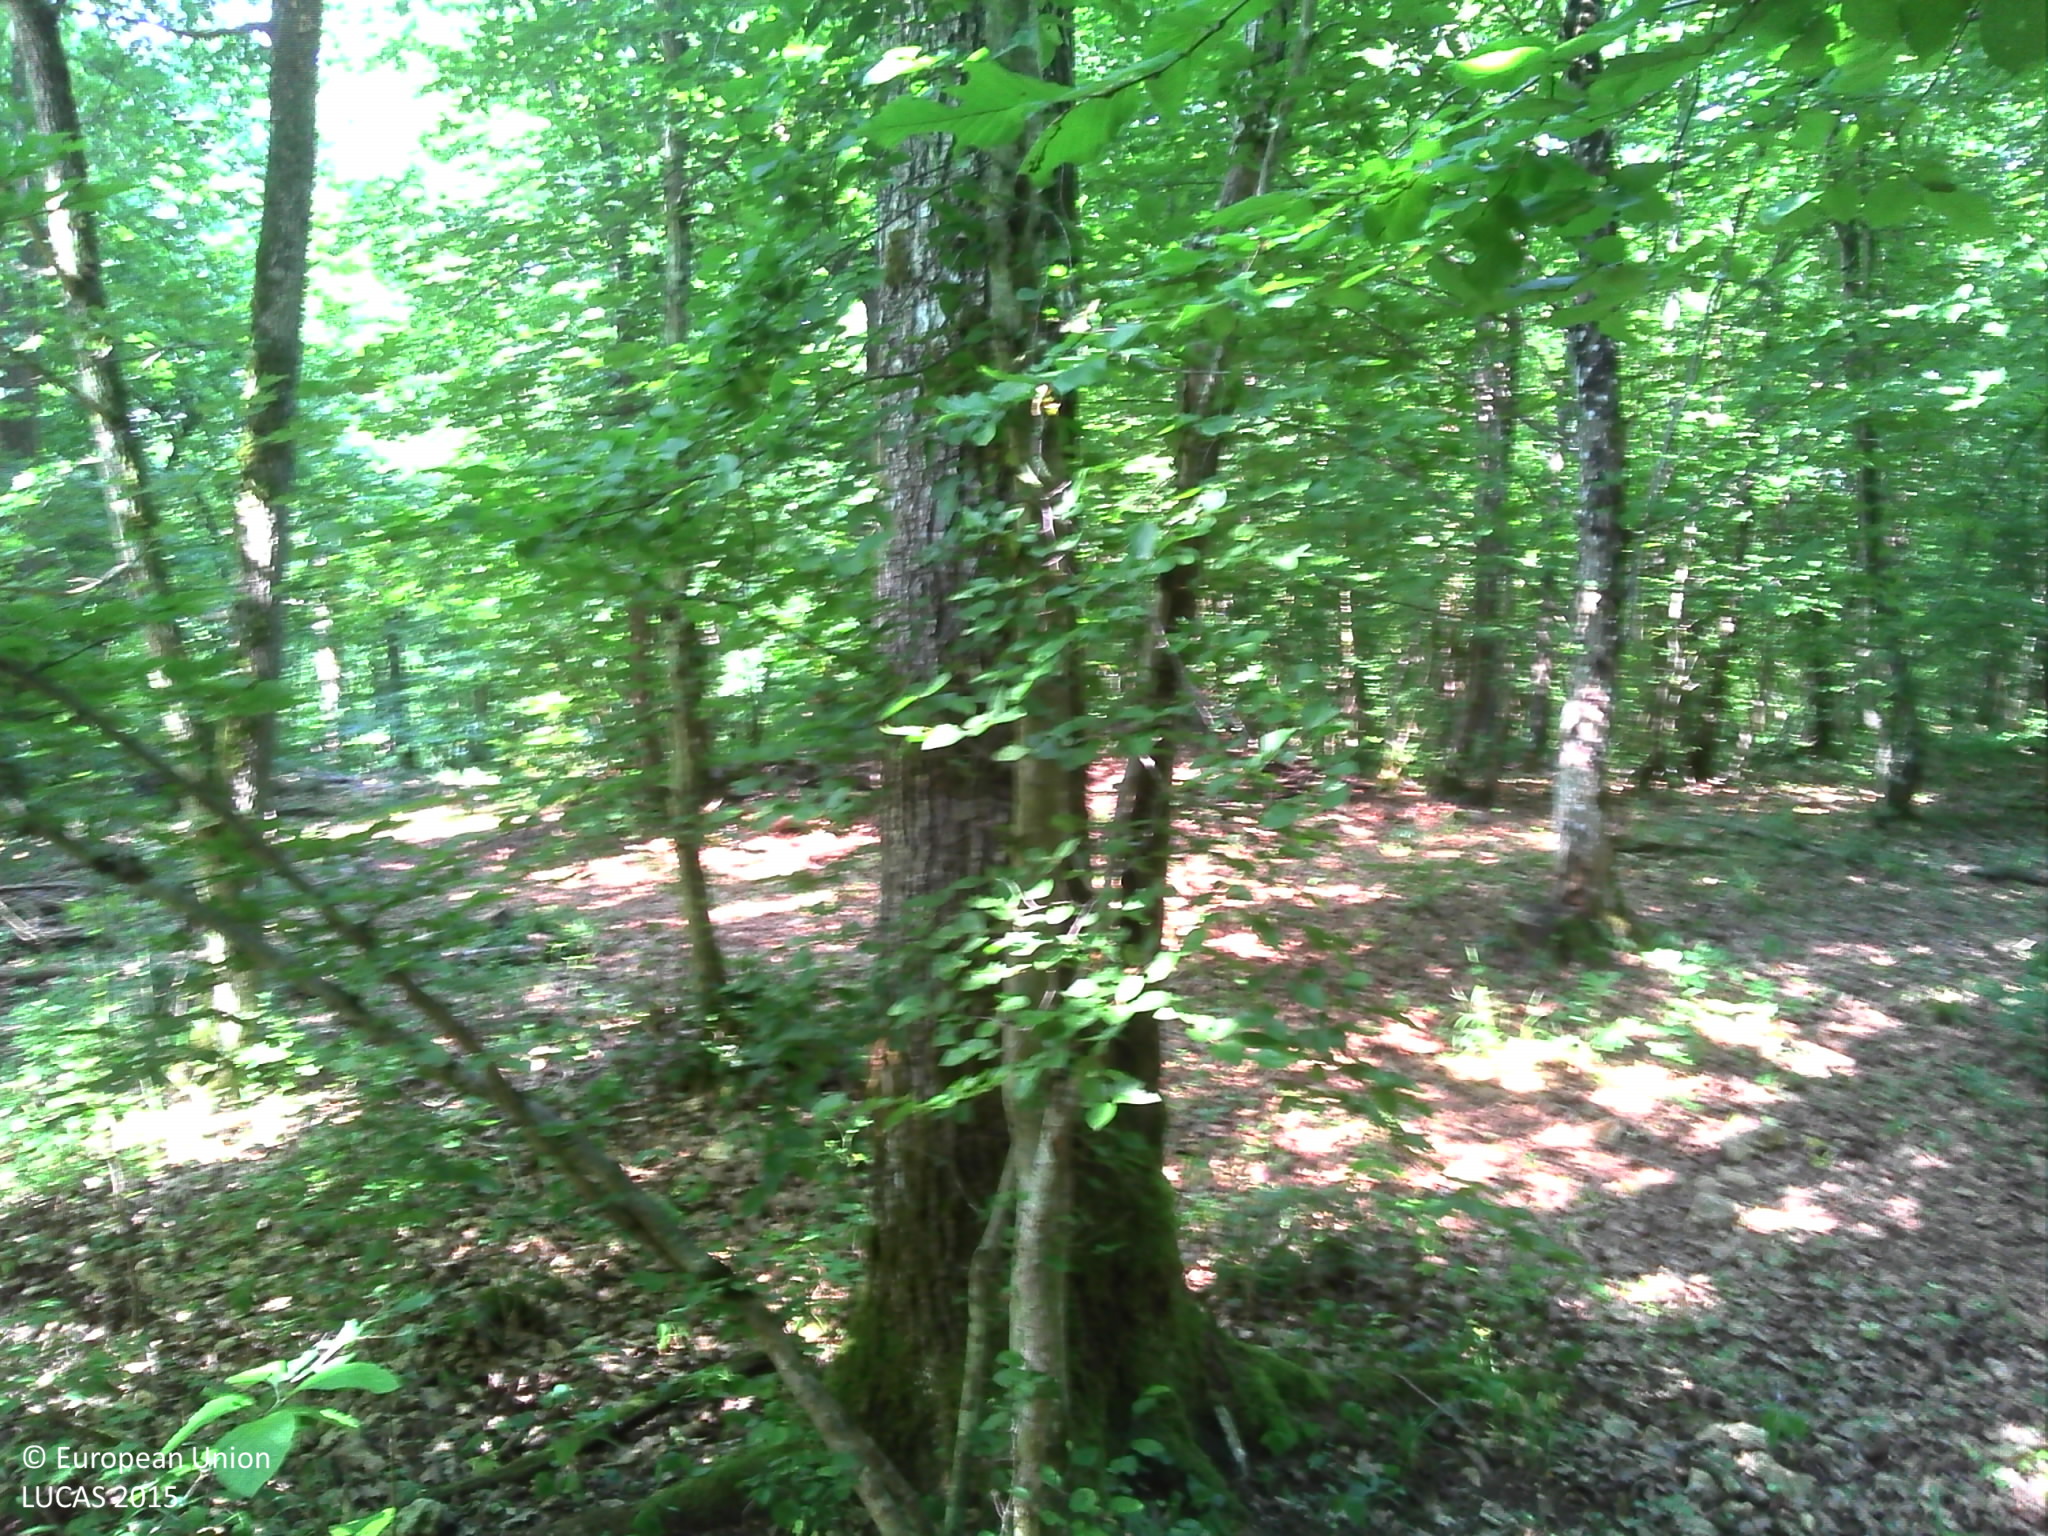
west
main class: Woodland
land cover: Broadleaved woodland
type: mesophytic deciduous forest
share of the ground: > 75 %
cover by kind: broadleaved forest trees 90 %, herbaceous plants 5 %, lichens and mosses 5 %
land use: Forestry
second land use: Amenities, museums, leisure
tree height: > 5 m
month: July
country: FR
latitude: 48.6392
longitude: 6.0508
